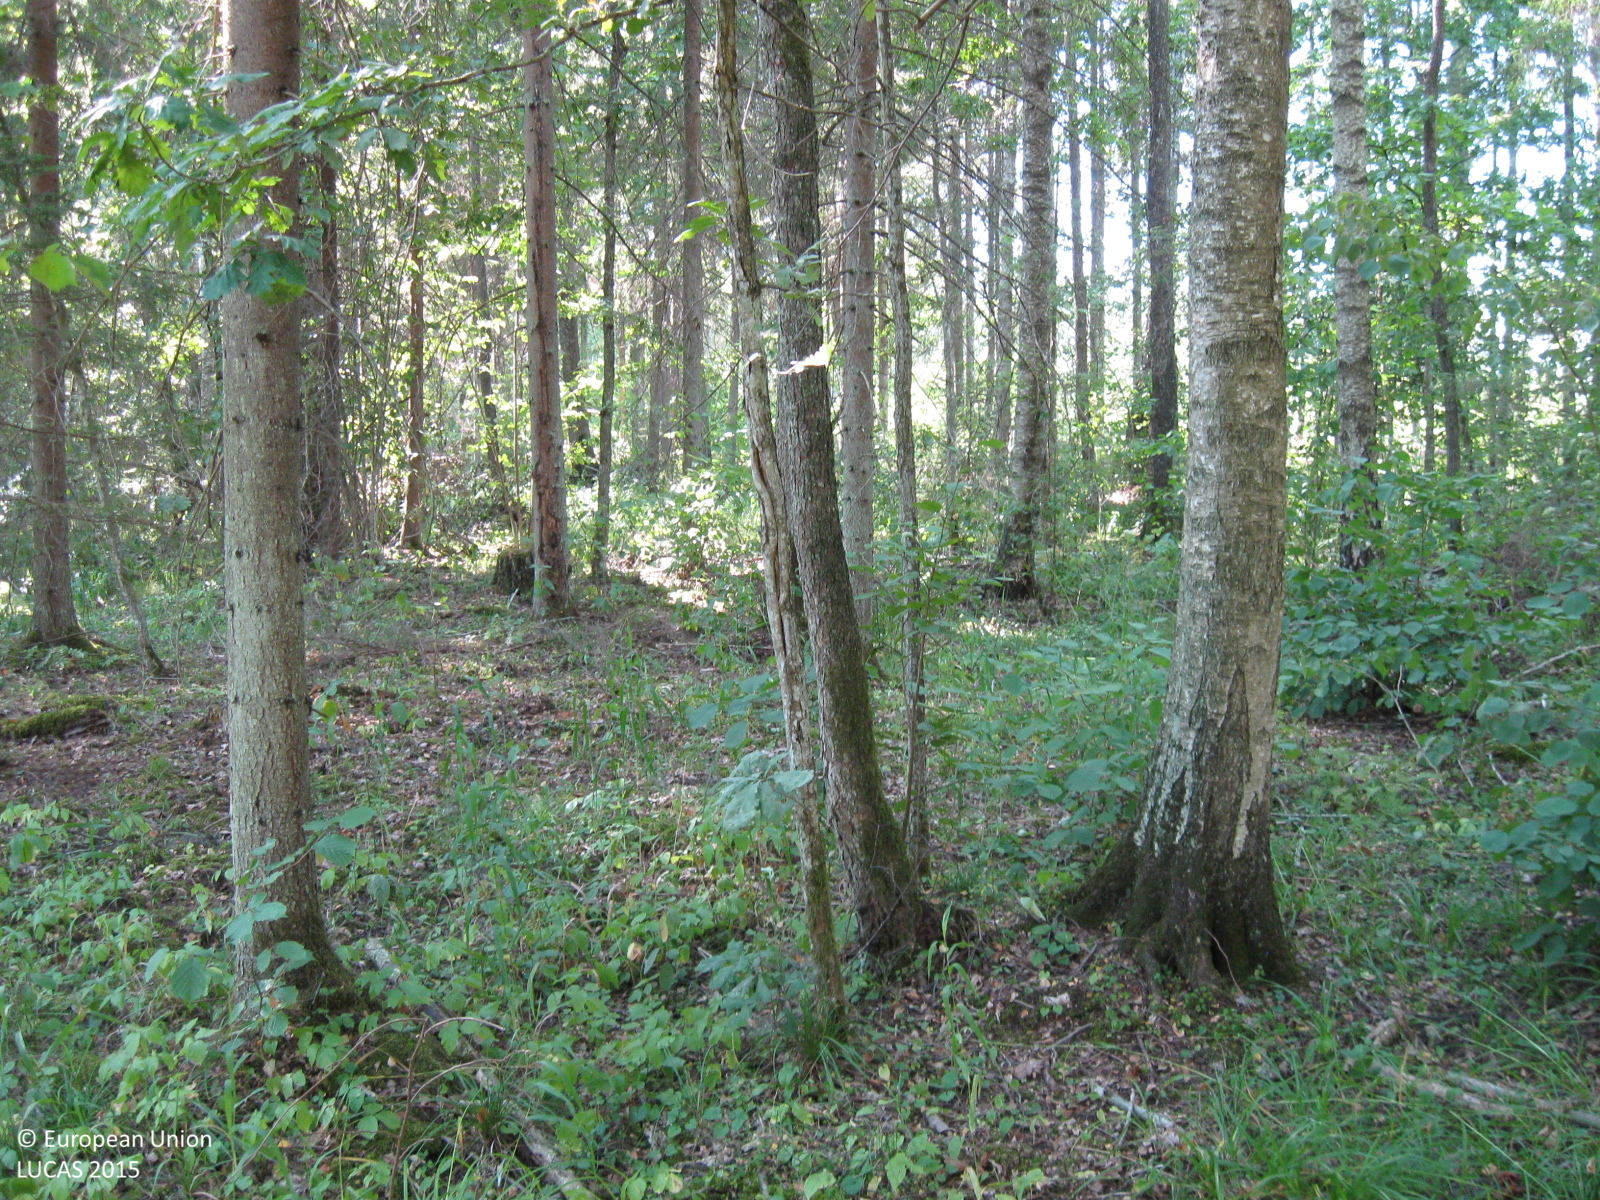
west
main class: Woodland
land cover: Spruce dominated mixed woodland
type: hemiboreal forest and nemoral coniferous forest and mixed broadleaved-coniferous forest
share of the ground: > 75 %
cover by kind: broadleaved forest trees 45 %, coniferous forest trees 40 %, herbaceous plants 10 %, lichens and mosses 5 %
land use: Forestry
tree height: > 5 m
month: August
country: LT
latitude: 55.3096
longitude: 22.5881
